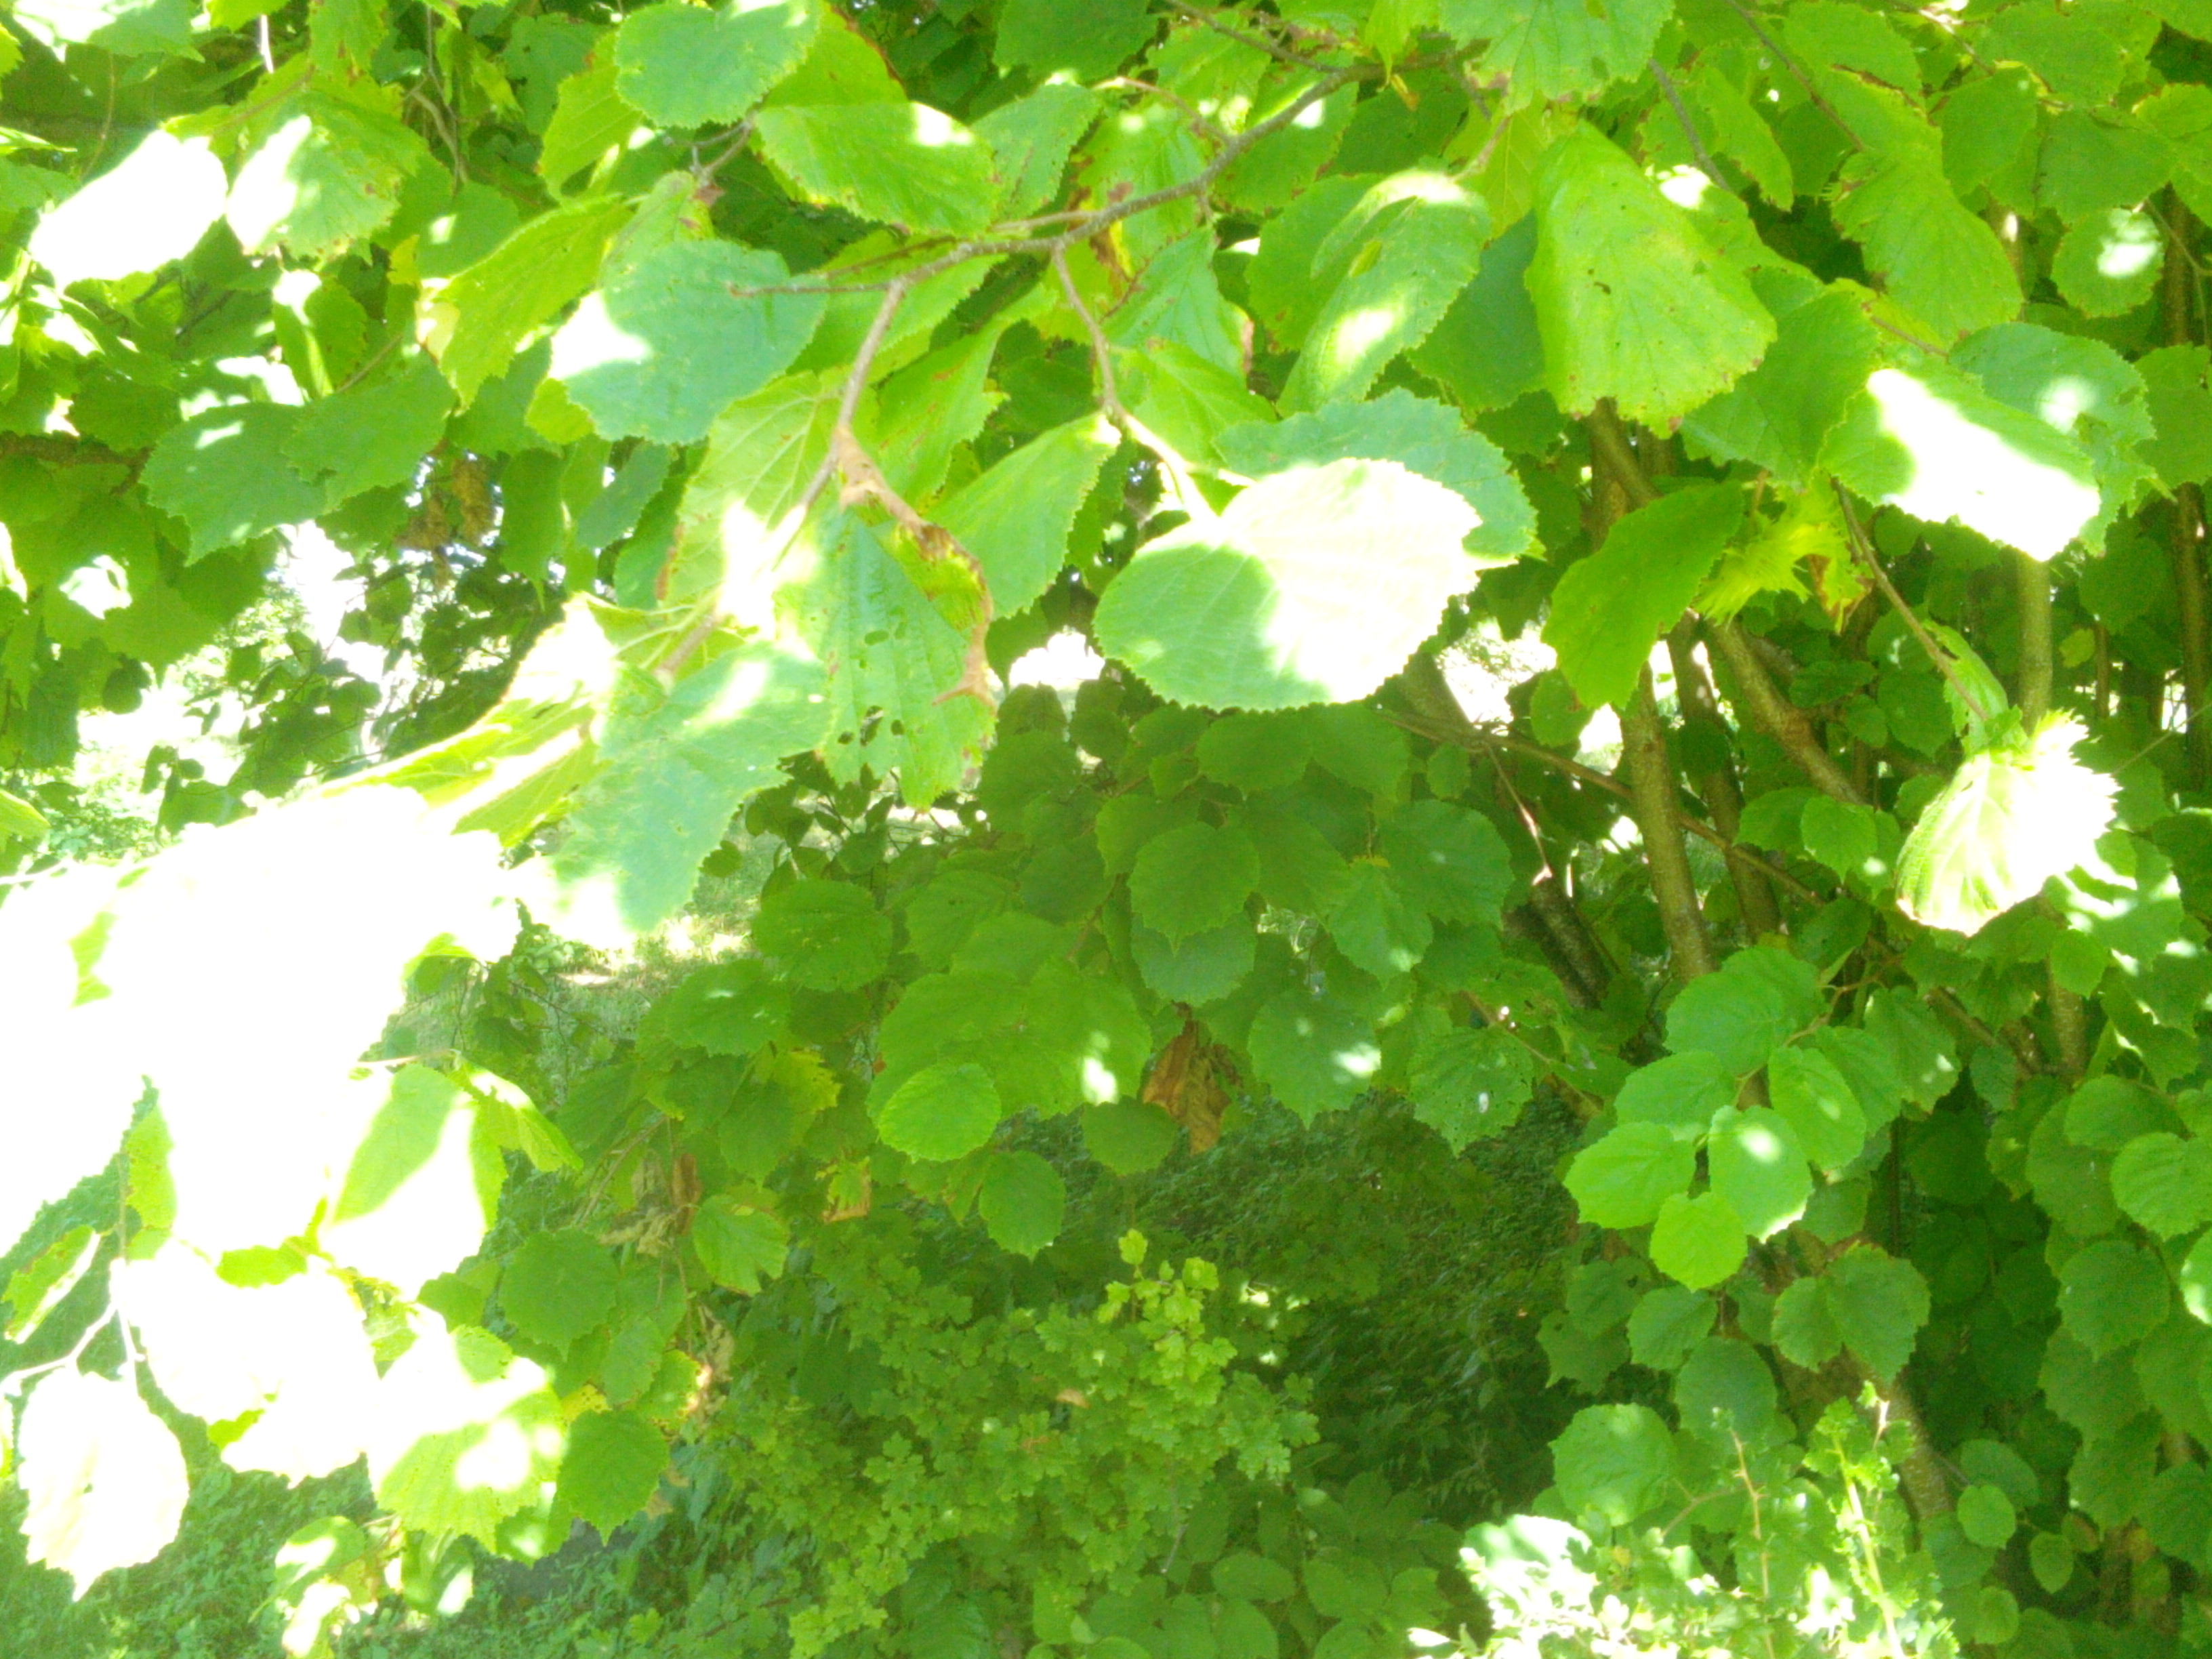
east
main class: Cropland
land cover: Apple fruit
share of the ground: 25 - 50 %
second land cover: Grassland without tree/shrub cover
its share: > 75 %
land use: Kitchen garden
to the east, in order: Apple fruit; Grassland without tree/shrub cover; Cherry fruit; Grass margins; Tracks; Grassland without tree/shrub cover; Electric lines; Grassland without tree/shrub cover; Paved roads, cycling and walking lanes
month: August
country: LV
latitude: 56.6103
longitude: 21.1323
